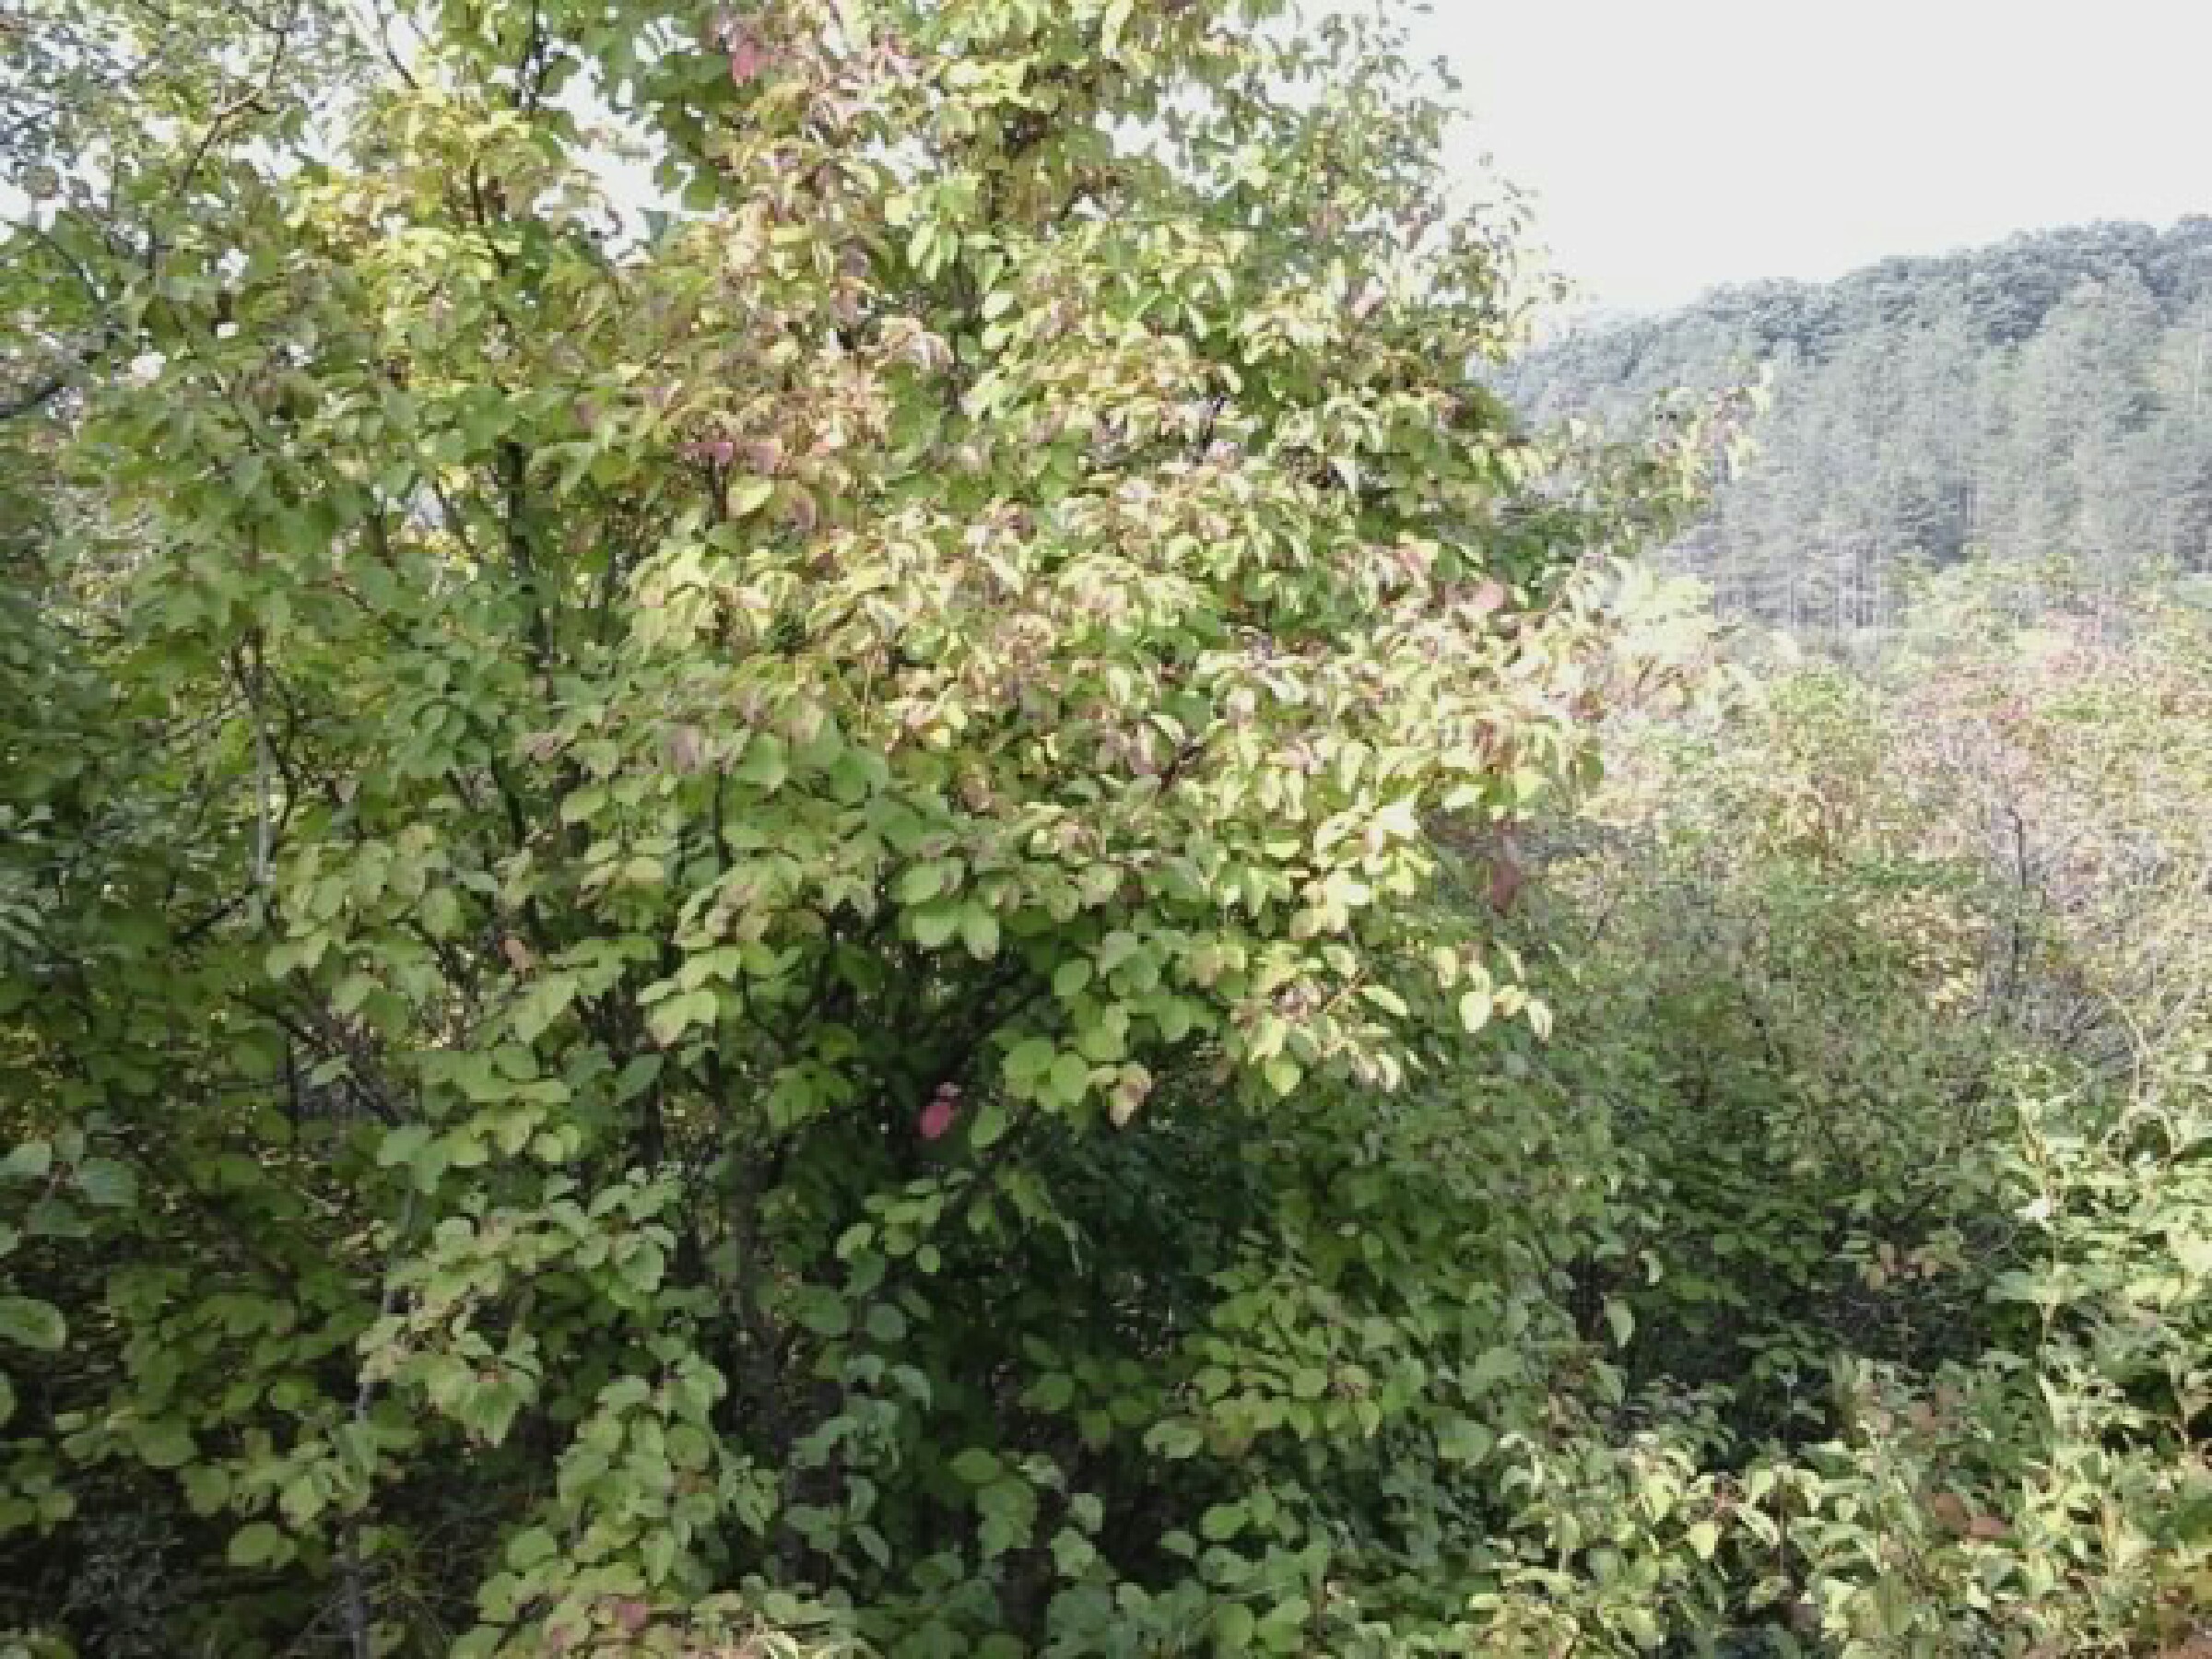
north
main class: Shrubland
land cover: Shrubland with sparse tree cover
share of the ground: > 75 %
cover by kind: shrubs 80 %, herbaceous plants 15 %, broadleaved forest trees 5 %
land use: Semi-natural and natural areas not in use
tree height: > 5 m
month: August
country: HU
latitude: 48.0519
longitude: 19.4546
